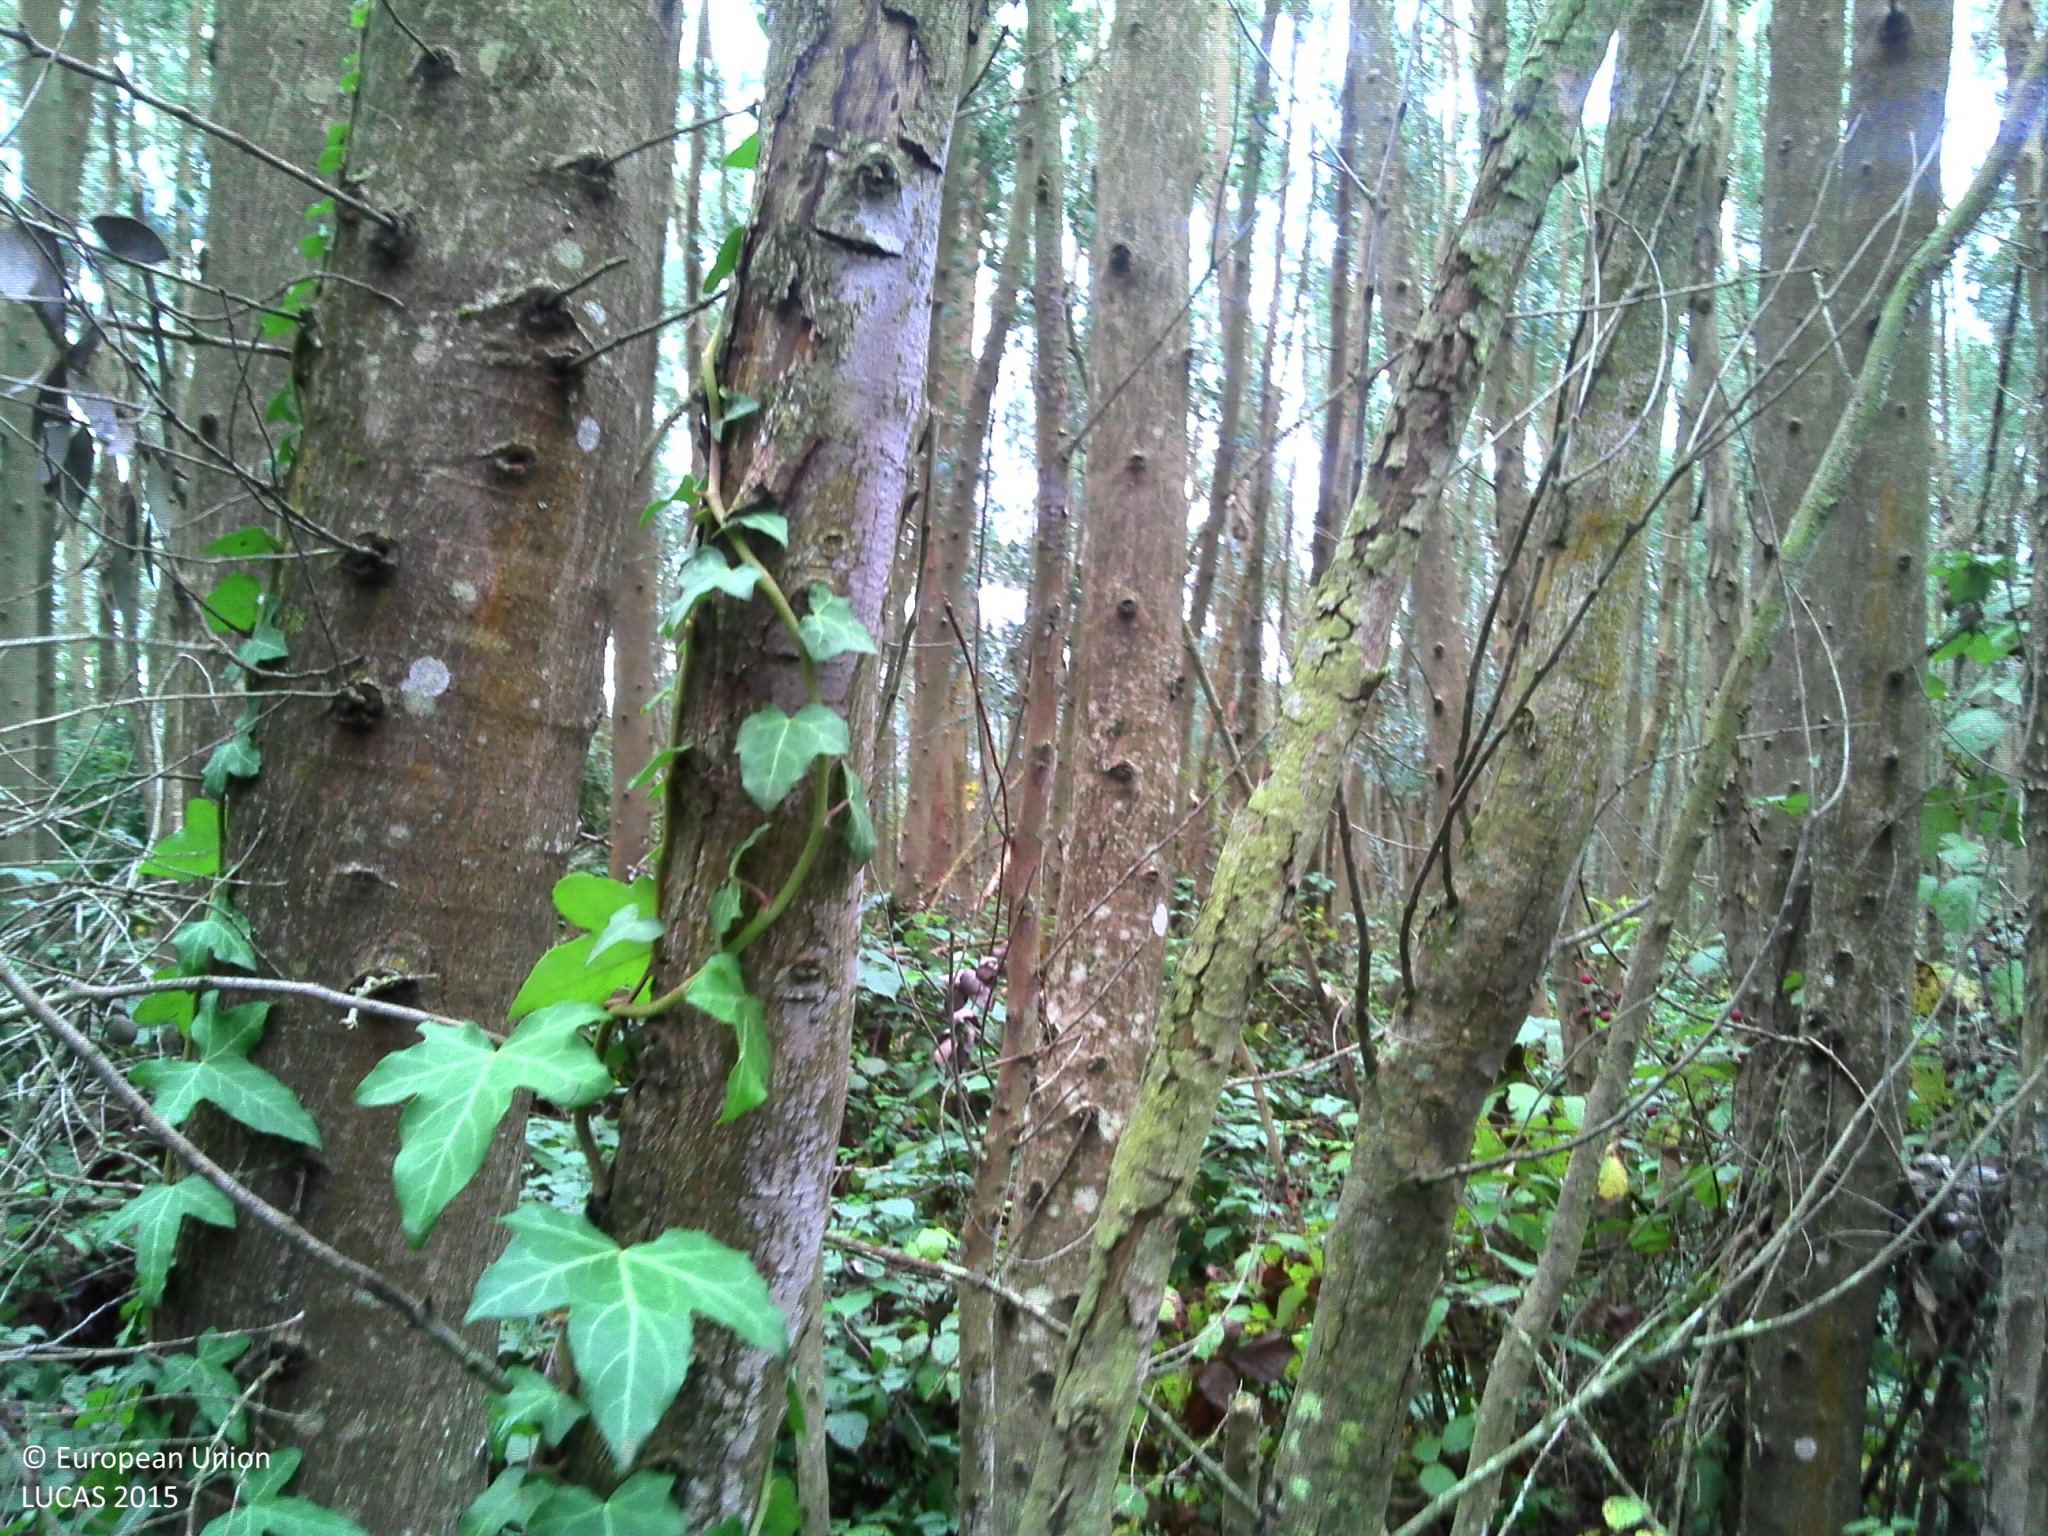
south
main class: Woodland
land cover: Broadleaved woodland
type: exotic forest
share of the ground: 50 - 75 %
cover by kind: broadleaved forest trees 60 %, shrubs 30 %, herbaceous plants 5 %, lichens and mosses 5 %
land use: Forestry
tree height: > 5 m
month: September
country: FR
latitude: 43.3813
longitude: -0.4878
